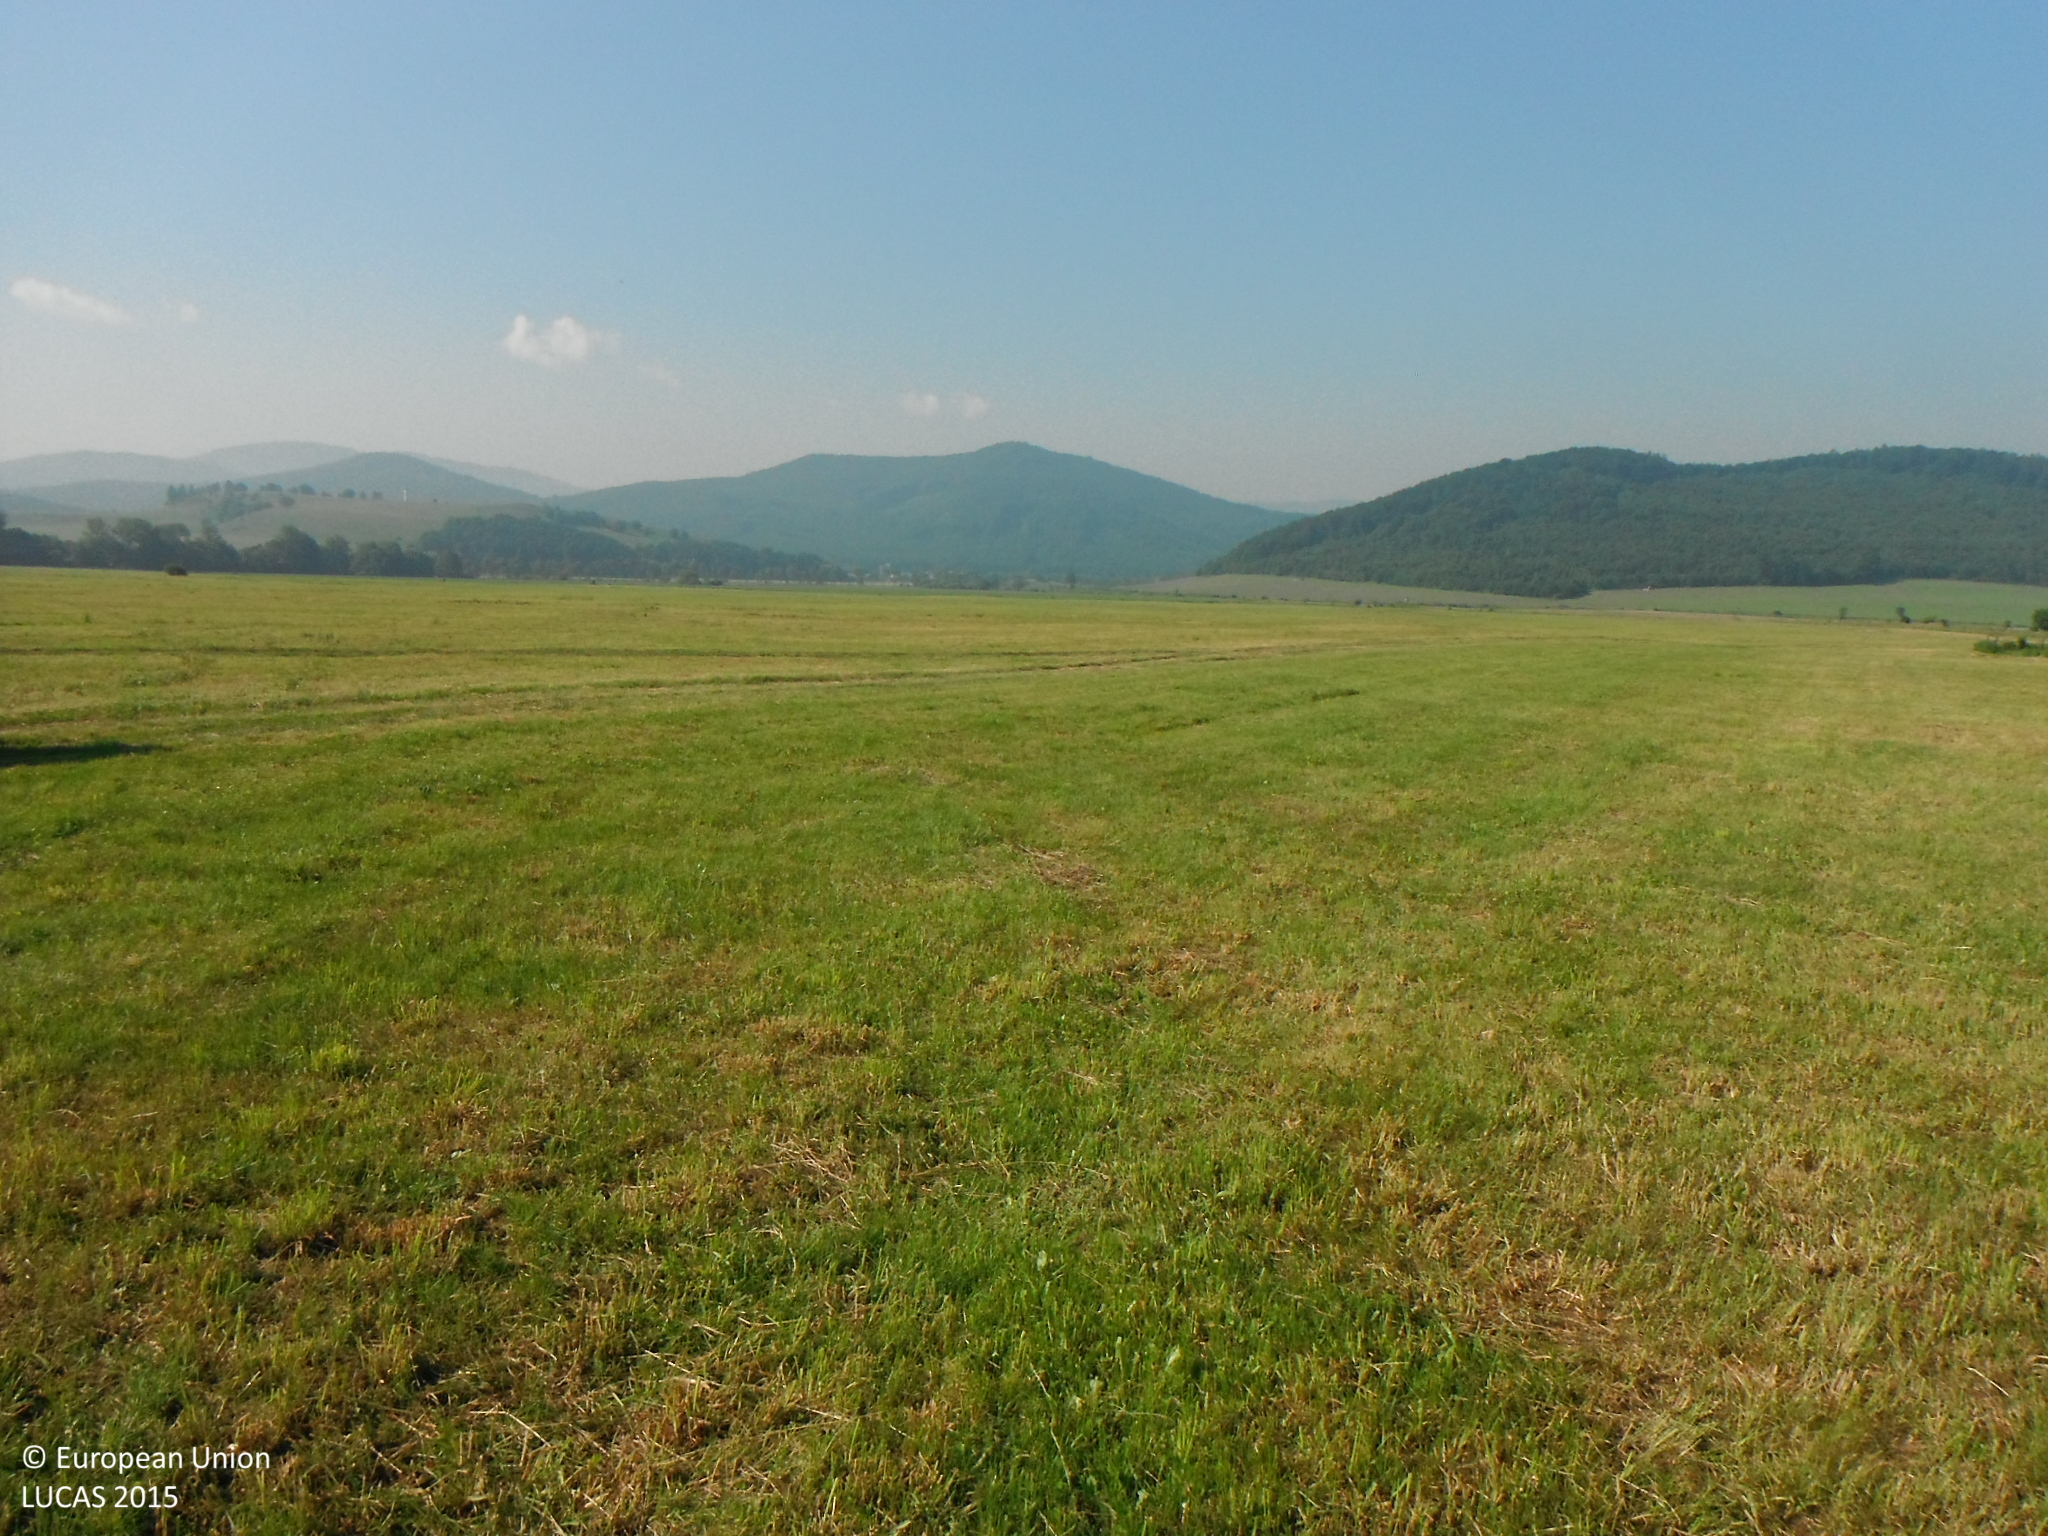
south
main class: Grassland
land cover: Grassland without tree/shrub cover
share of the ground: > 75 %
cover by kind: herbaceous plants 100 %
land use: Agriculture (excluding fallow land and kitchen gardens)
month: June
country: SK
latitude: 48.5849
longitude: 19.3642
